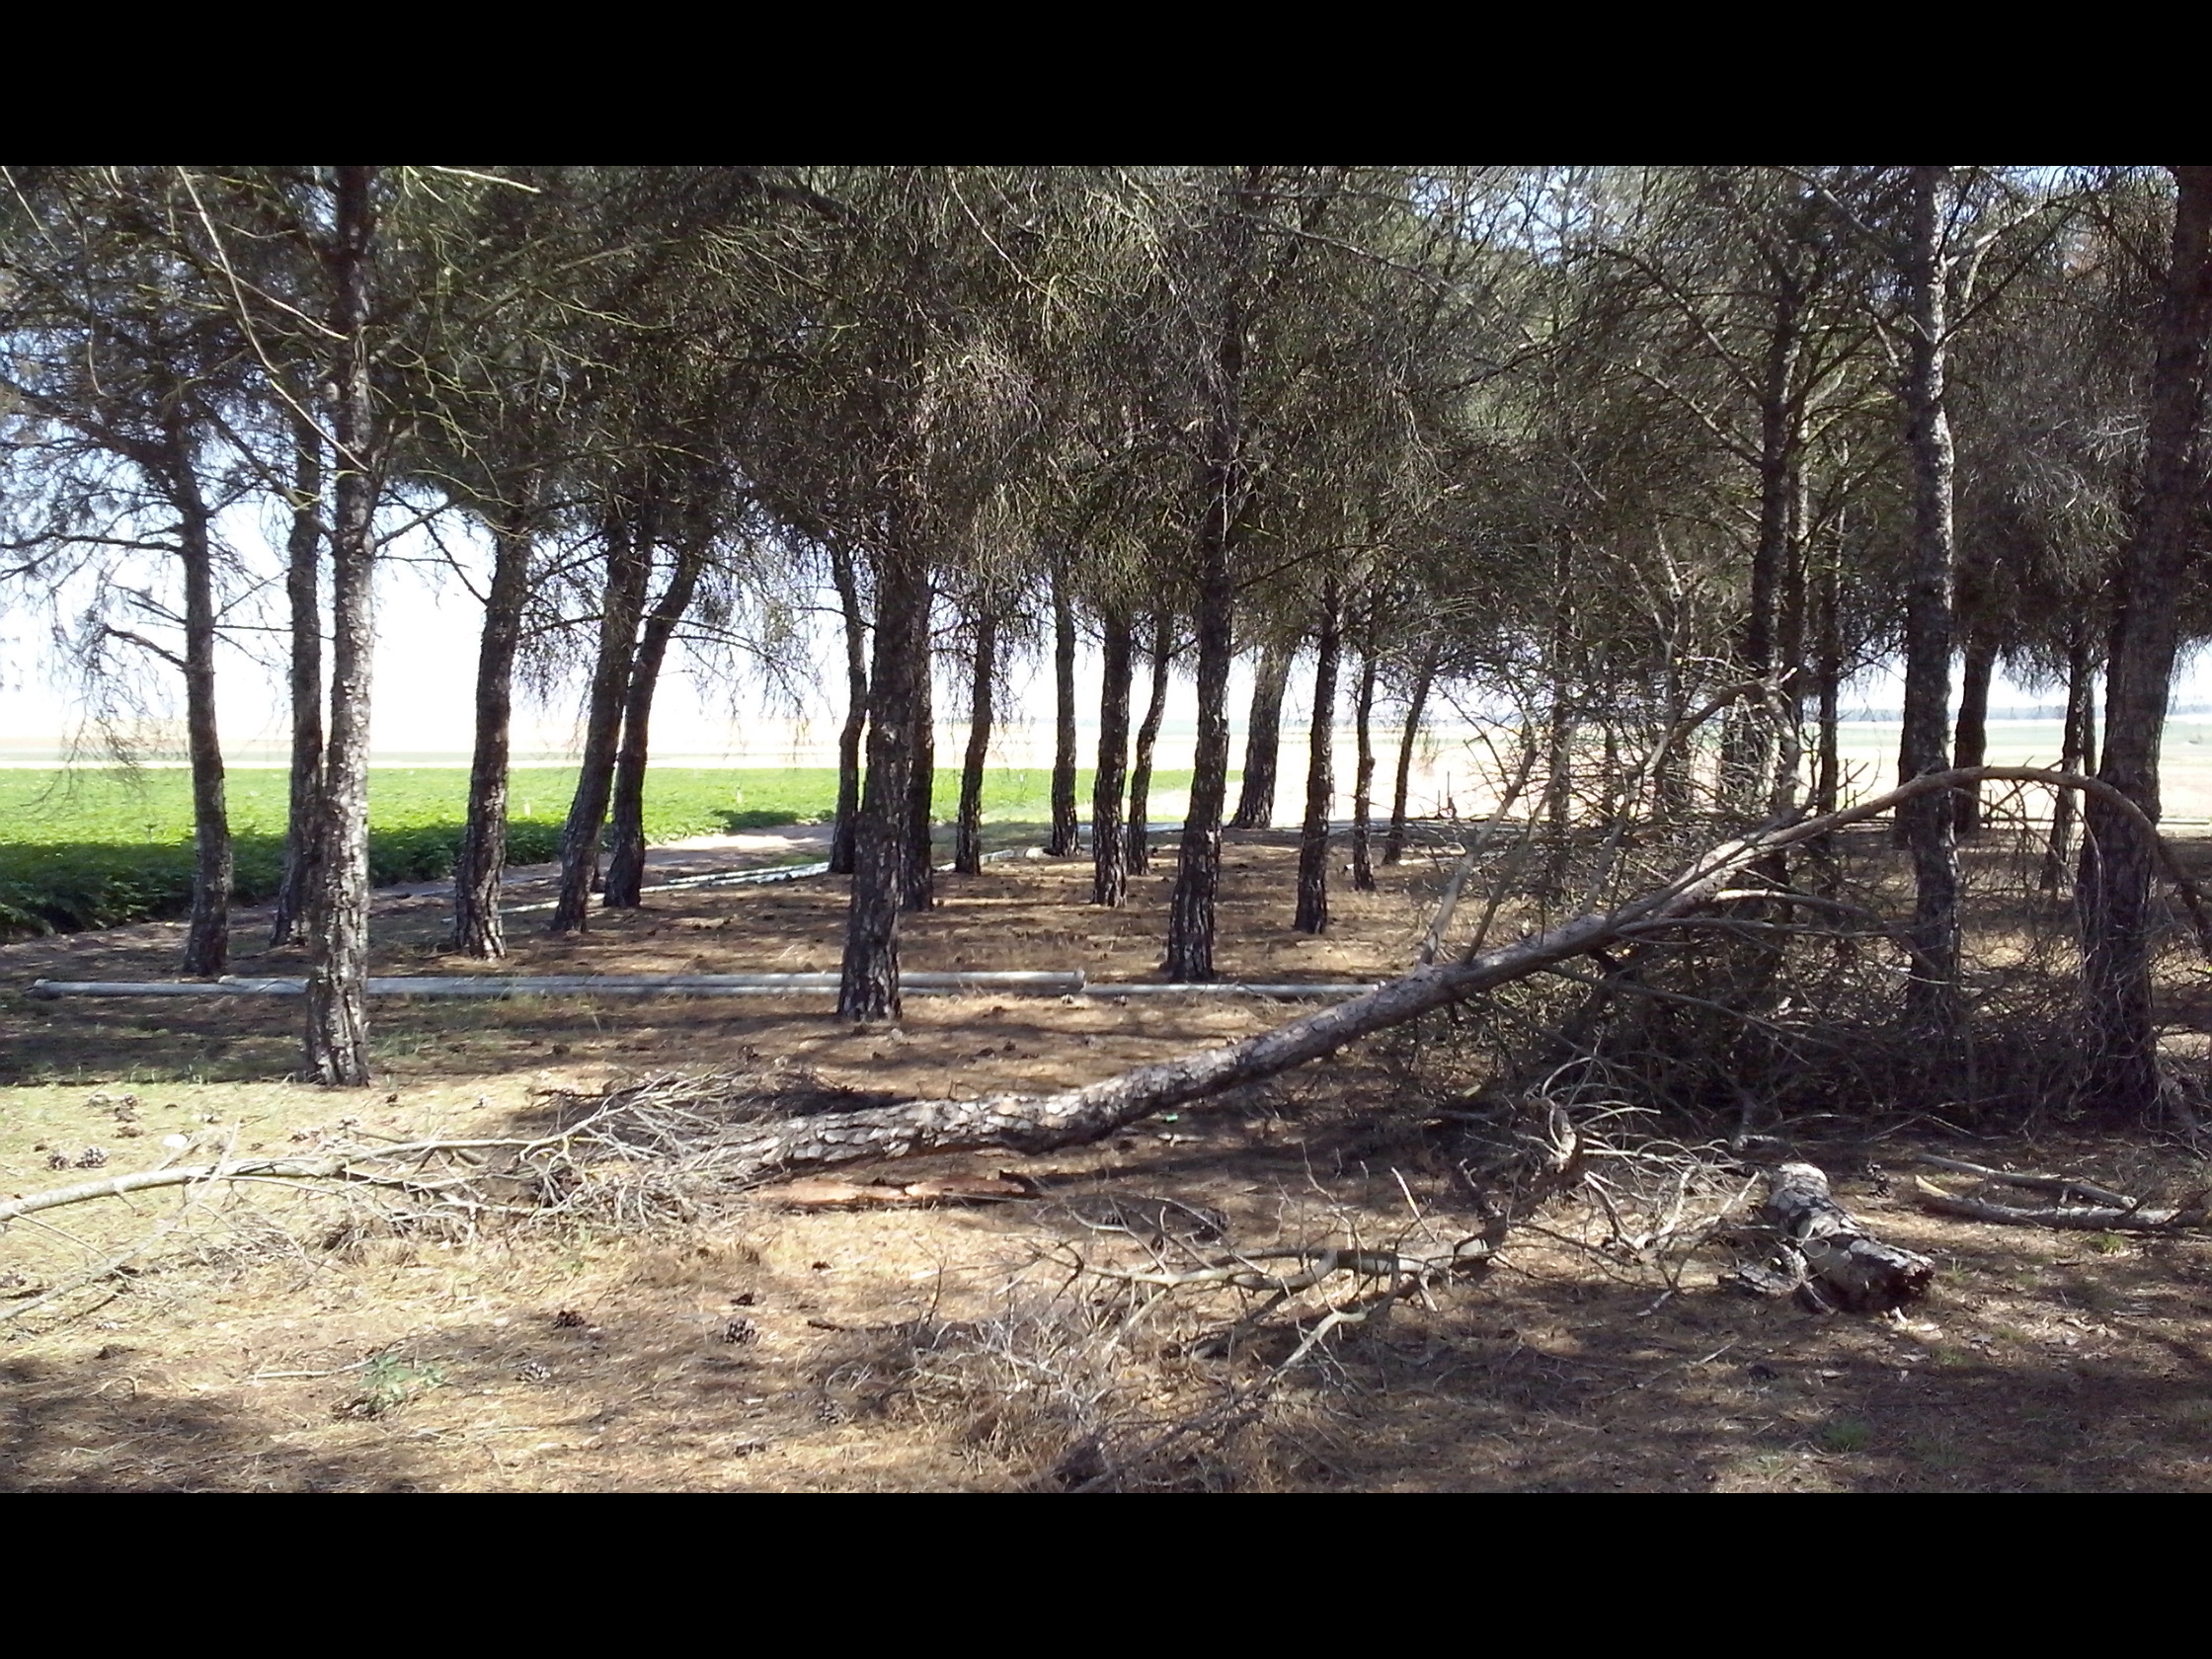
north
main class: Woodland
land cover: Pine dominated coniferous woodland
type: coniferous forest of the mediterranean region
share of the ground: 50 - 75 %
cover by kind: coniferous forest trees 60 %, herbaceous plants 25 %, unconsolidated bare surface 15 %
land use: Forestry
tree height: > 5 m
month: July
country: ES
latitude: 41.5163
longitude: -5.0879
